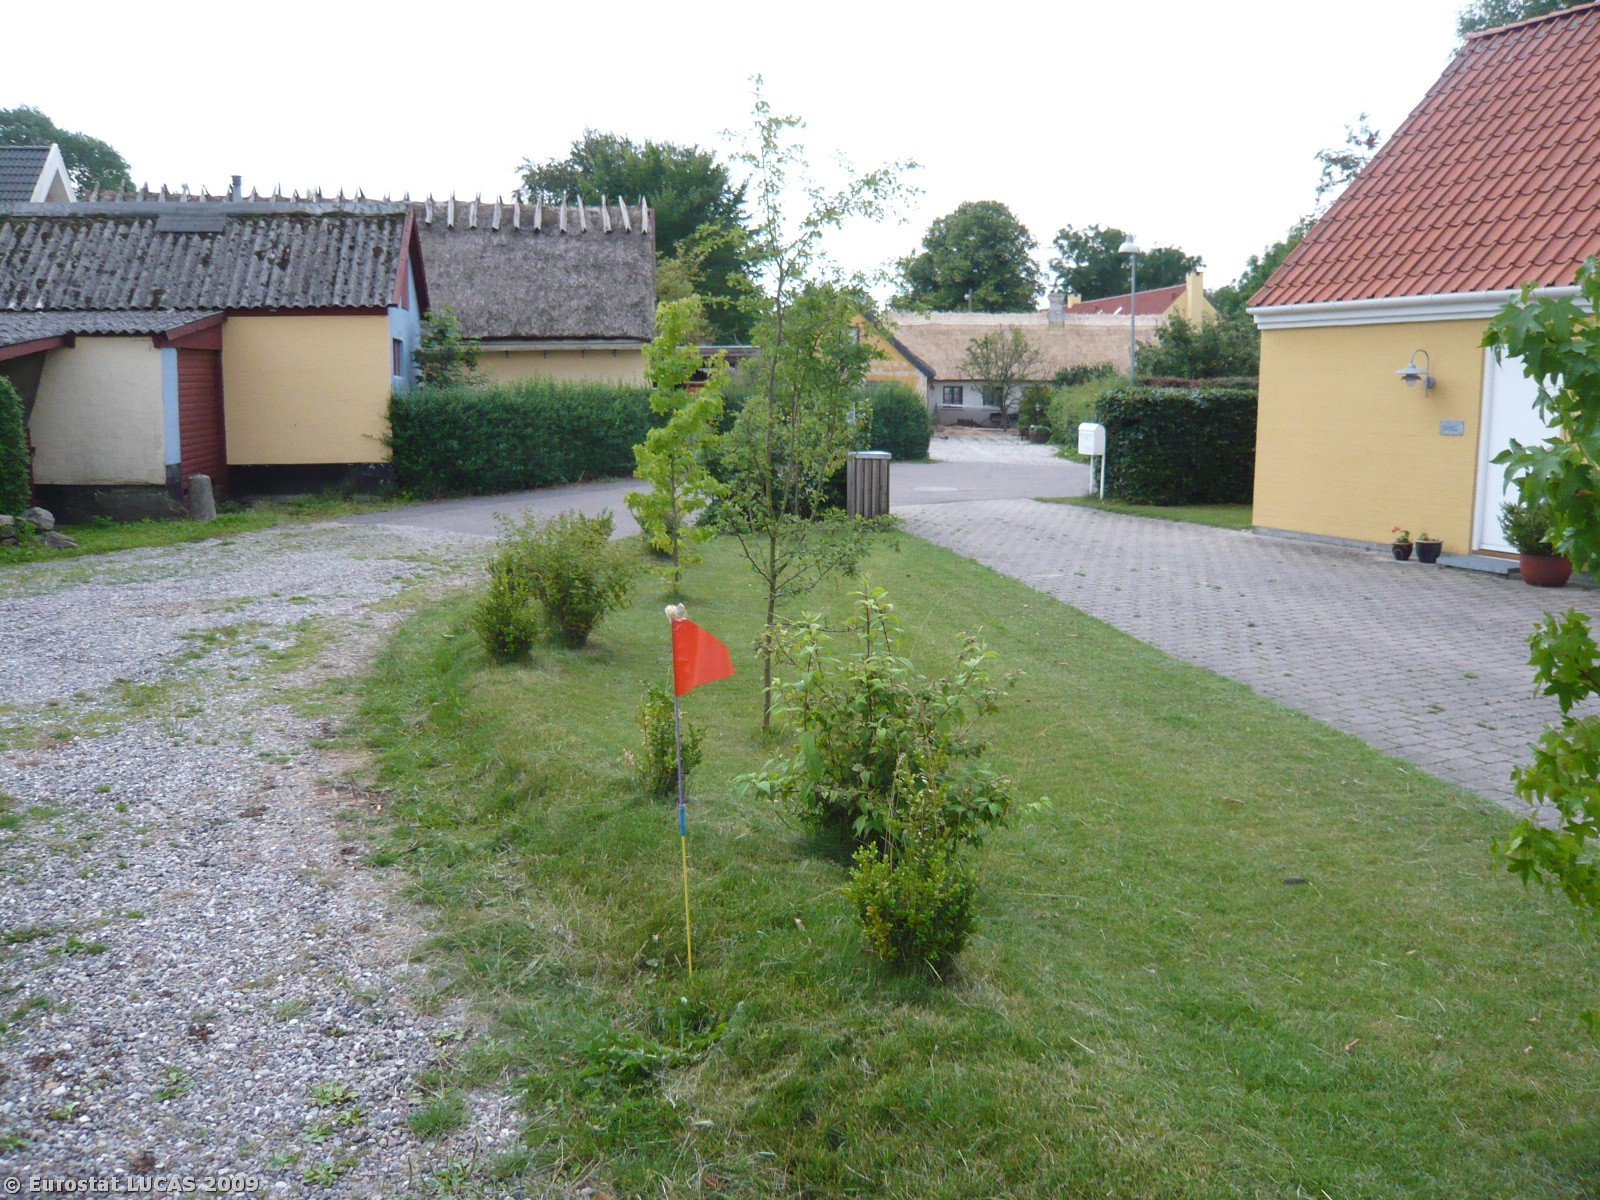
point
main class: Grassland
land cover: Grassland with sparse tree/shrub cover
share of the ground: > 75 %
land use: Residential
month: July
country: DK
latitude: 55.7360
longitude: 12.2755
